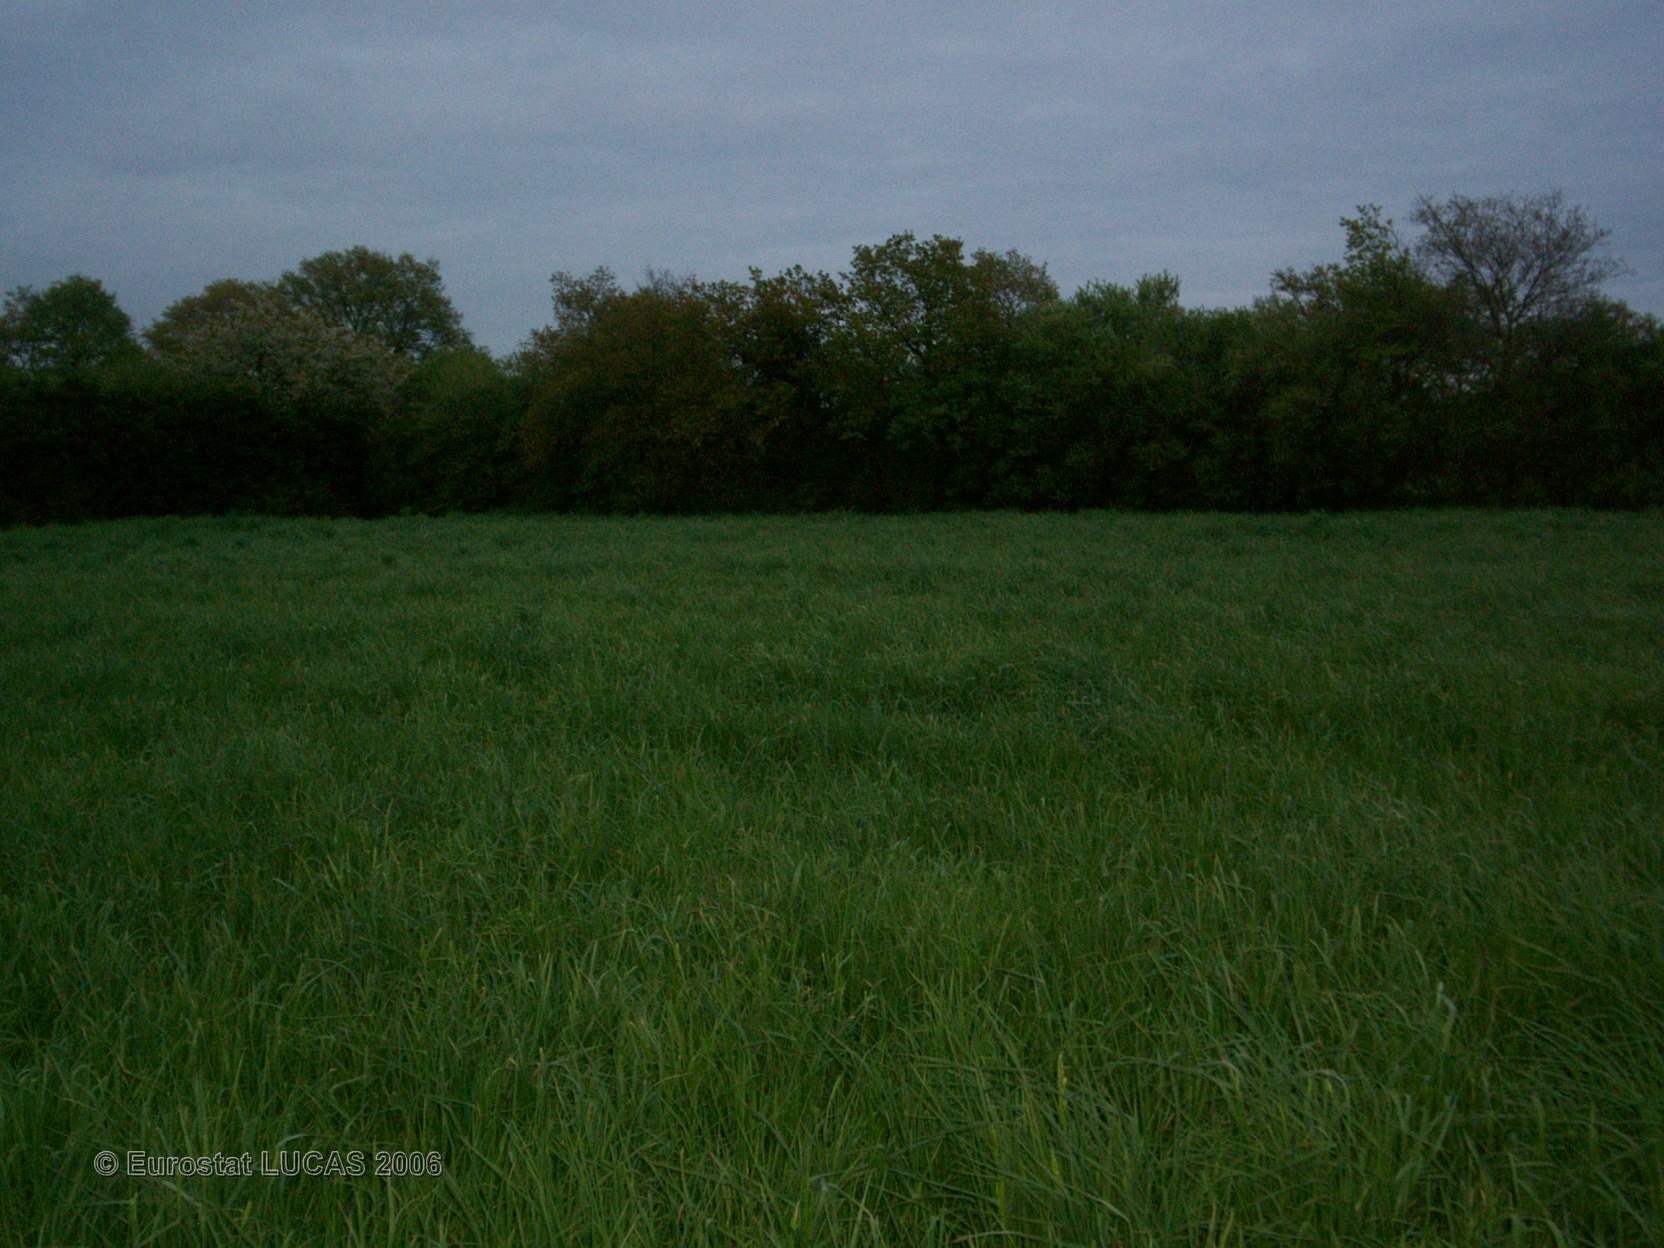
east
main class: Grassland
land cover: Grassland without tree/shrub cover
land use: Agriculture (excluding fallow land and kitchen gardens)
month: May
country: FR
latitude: 47.8604
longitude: -0.1745
